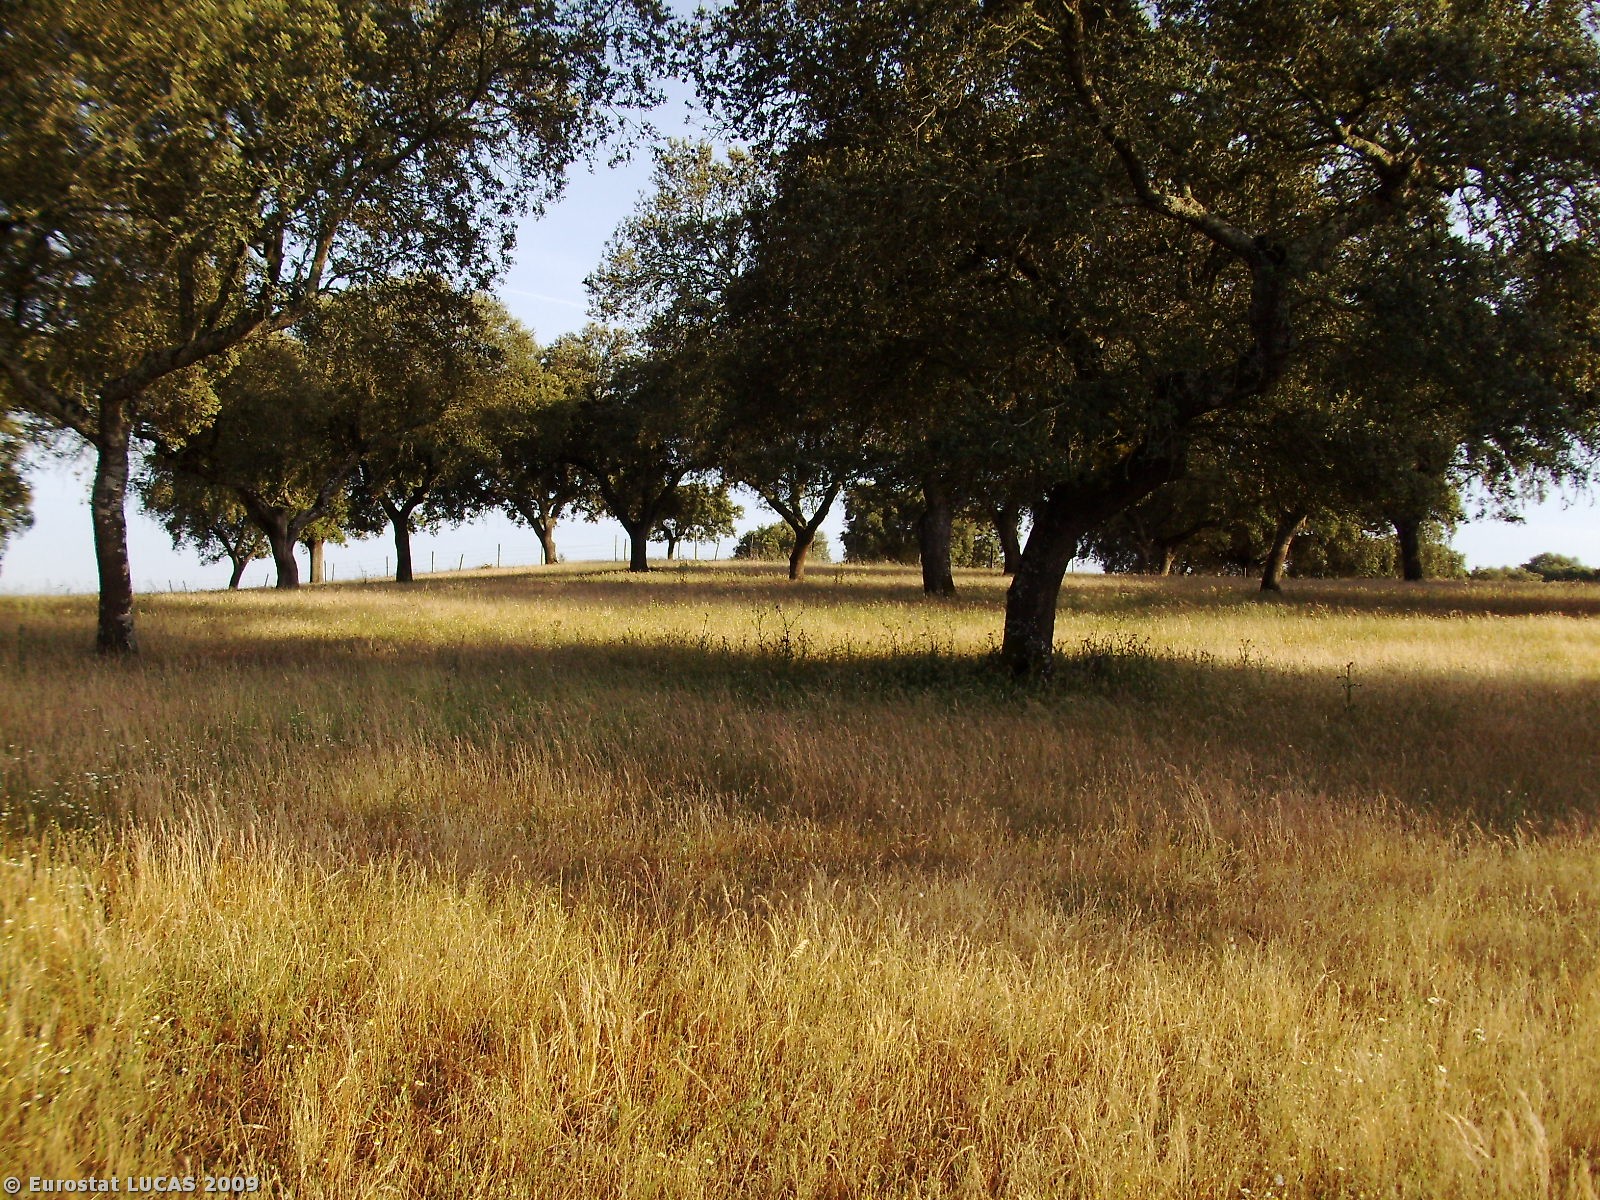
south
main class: Woodland
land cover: Broadleaved woodland
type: broadleaved evergreen forest
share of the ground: 25 - 50 %
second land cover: Grassland with sparse tree/shrub cover
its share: 50 - 75 %
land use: Forestry
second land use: Agriculture (excluding fallow land and kitchen gardens)
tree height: > 5 m
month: June
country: PT
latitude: 39.0316
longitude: -7.3984
